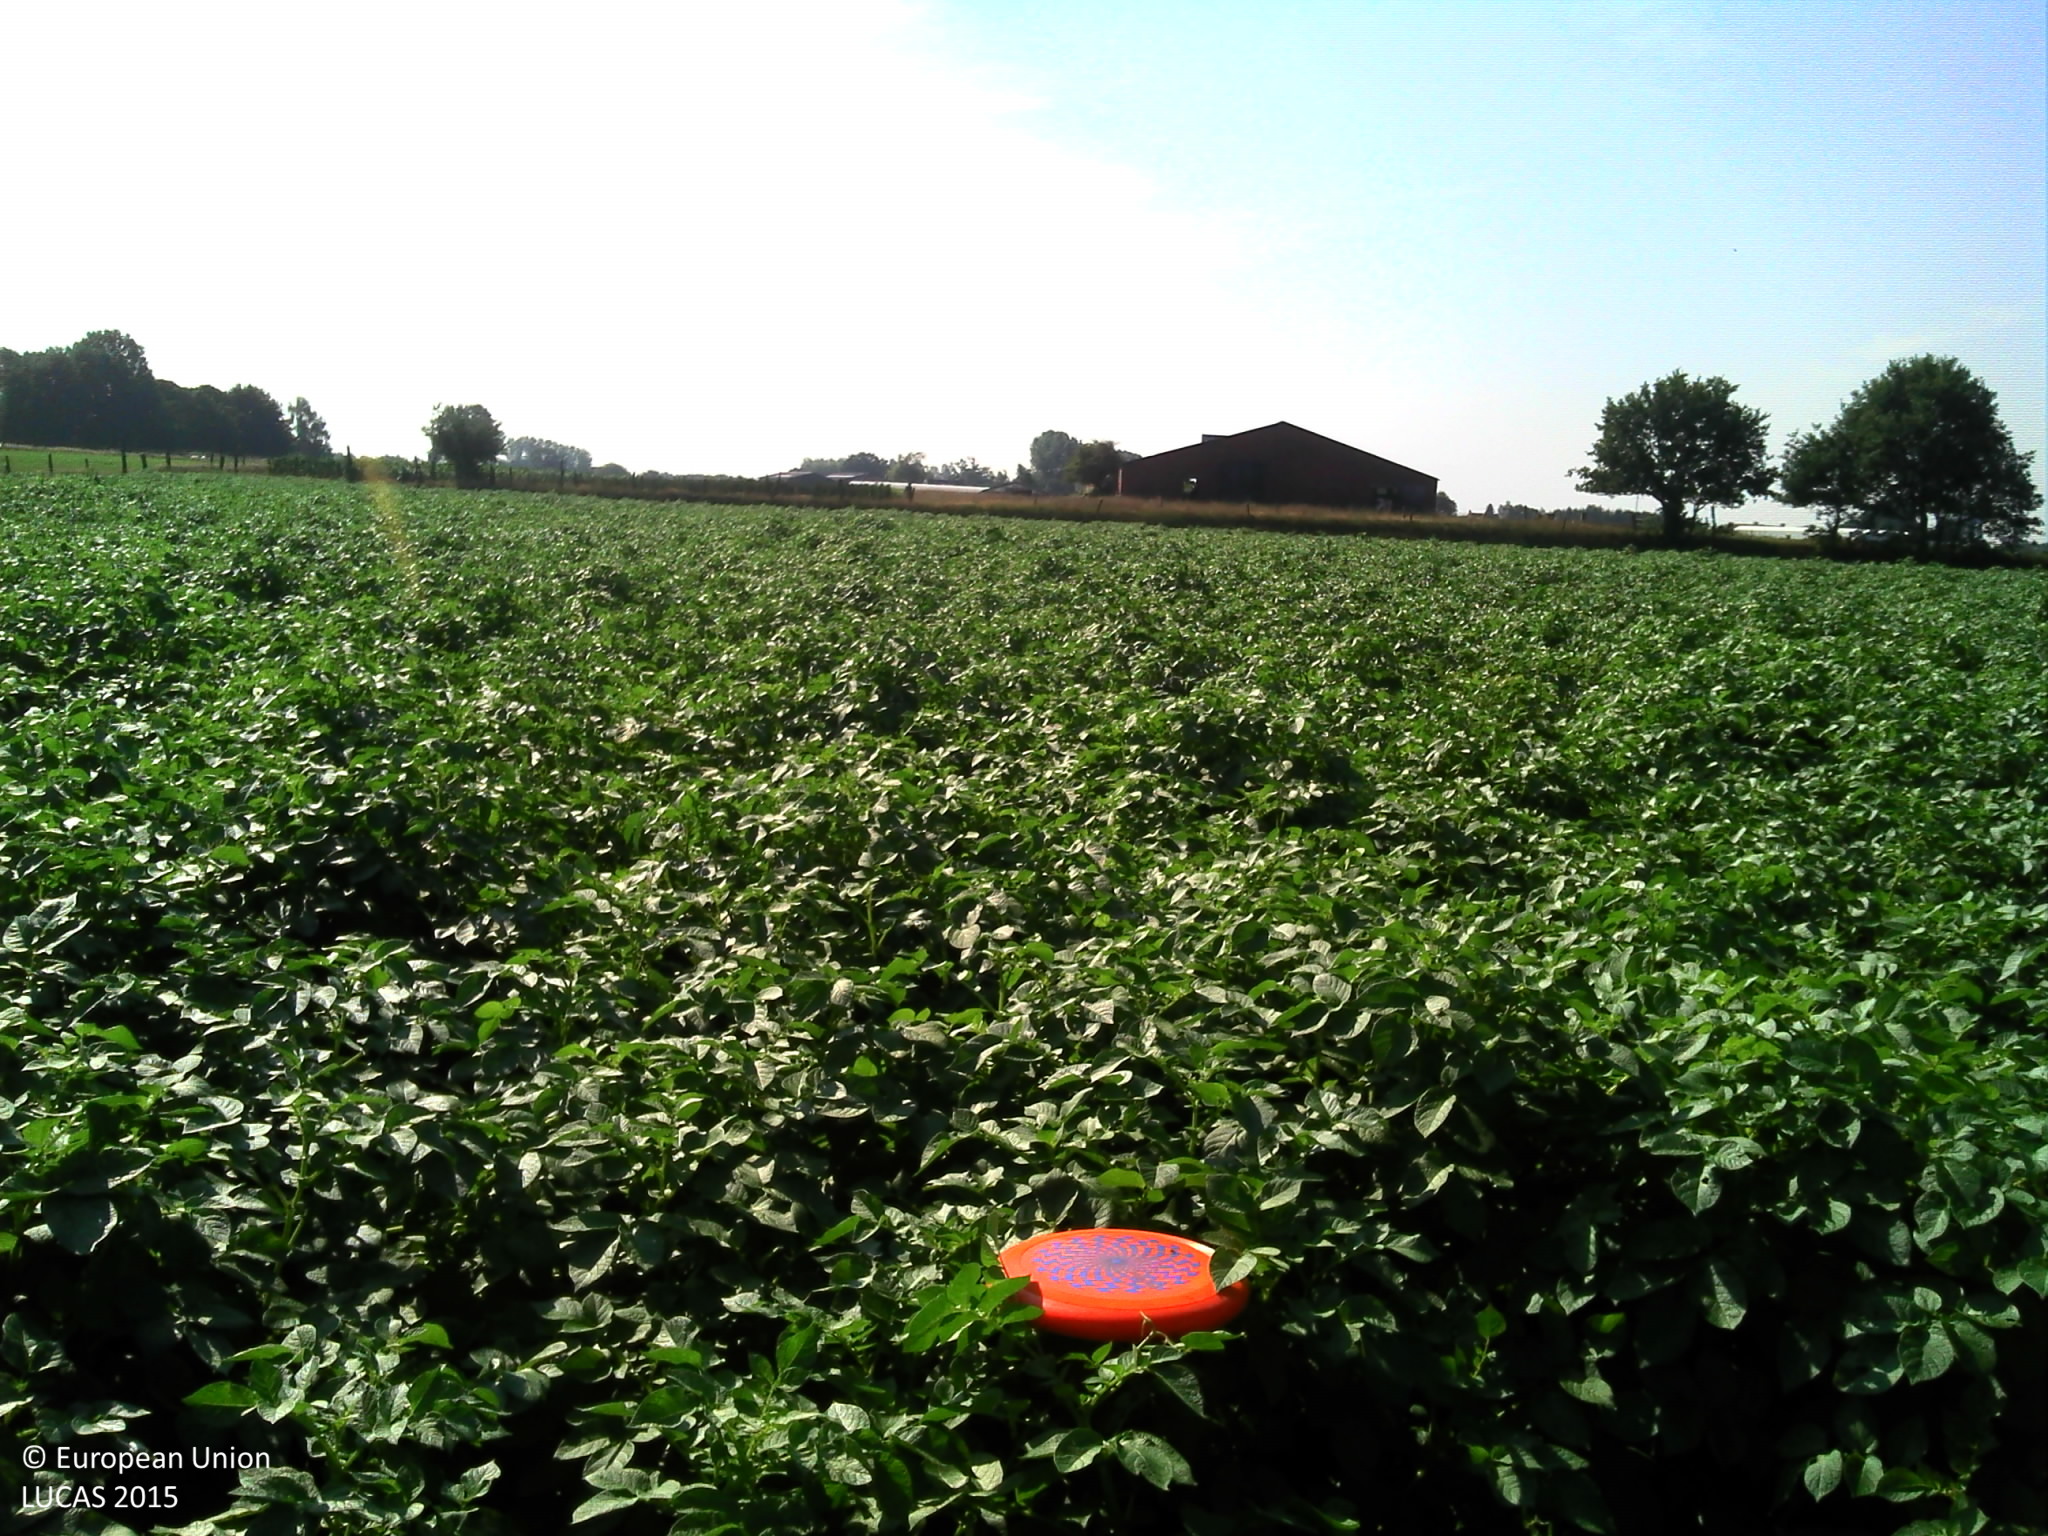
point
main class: Cropland
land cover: Potatoes
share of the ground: > 75 %
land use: Agriculture (excluding fallow land and kitchen gardens)
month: August
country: BE
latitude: 51.2682
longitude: 5.1099
